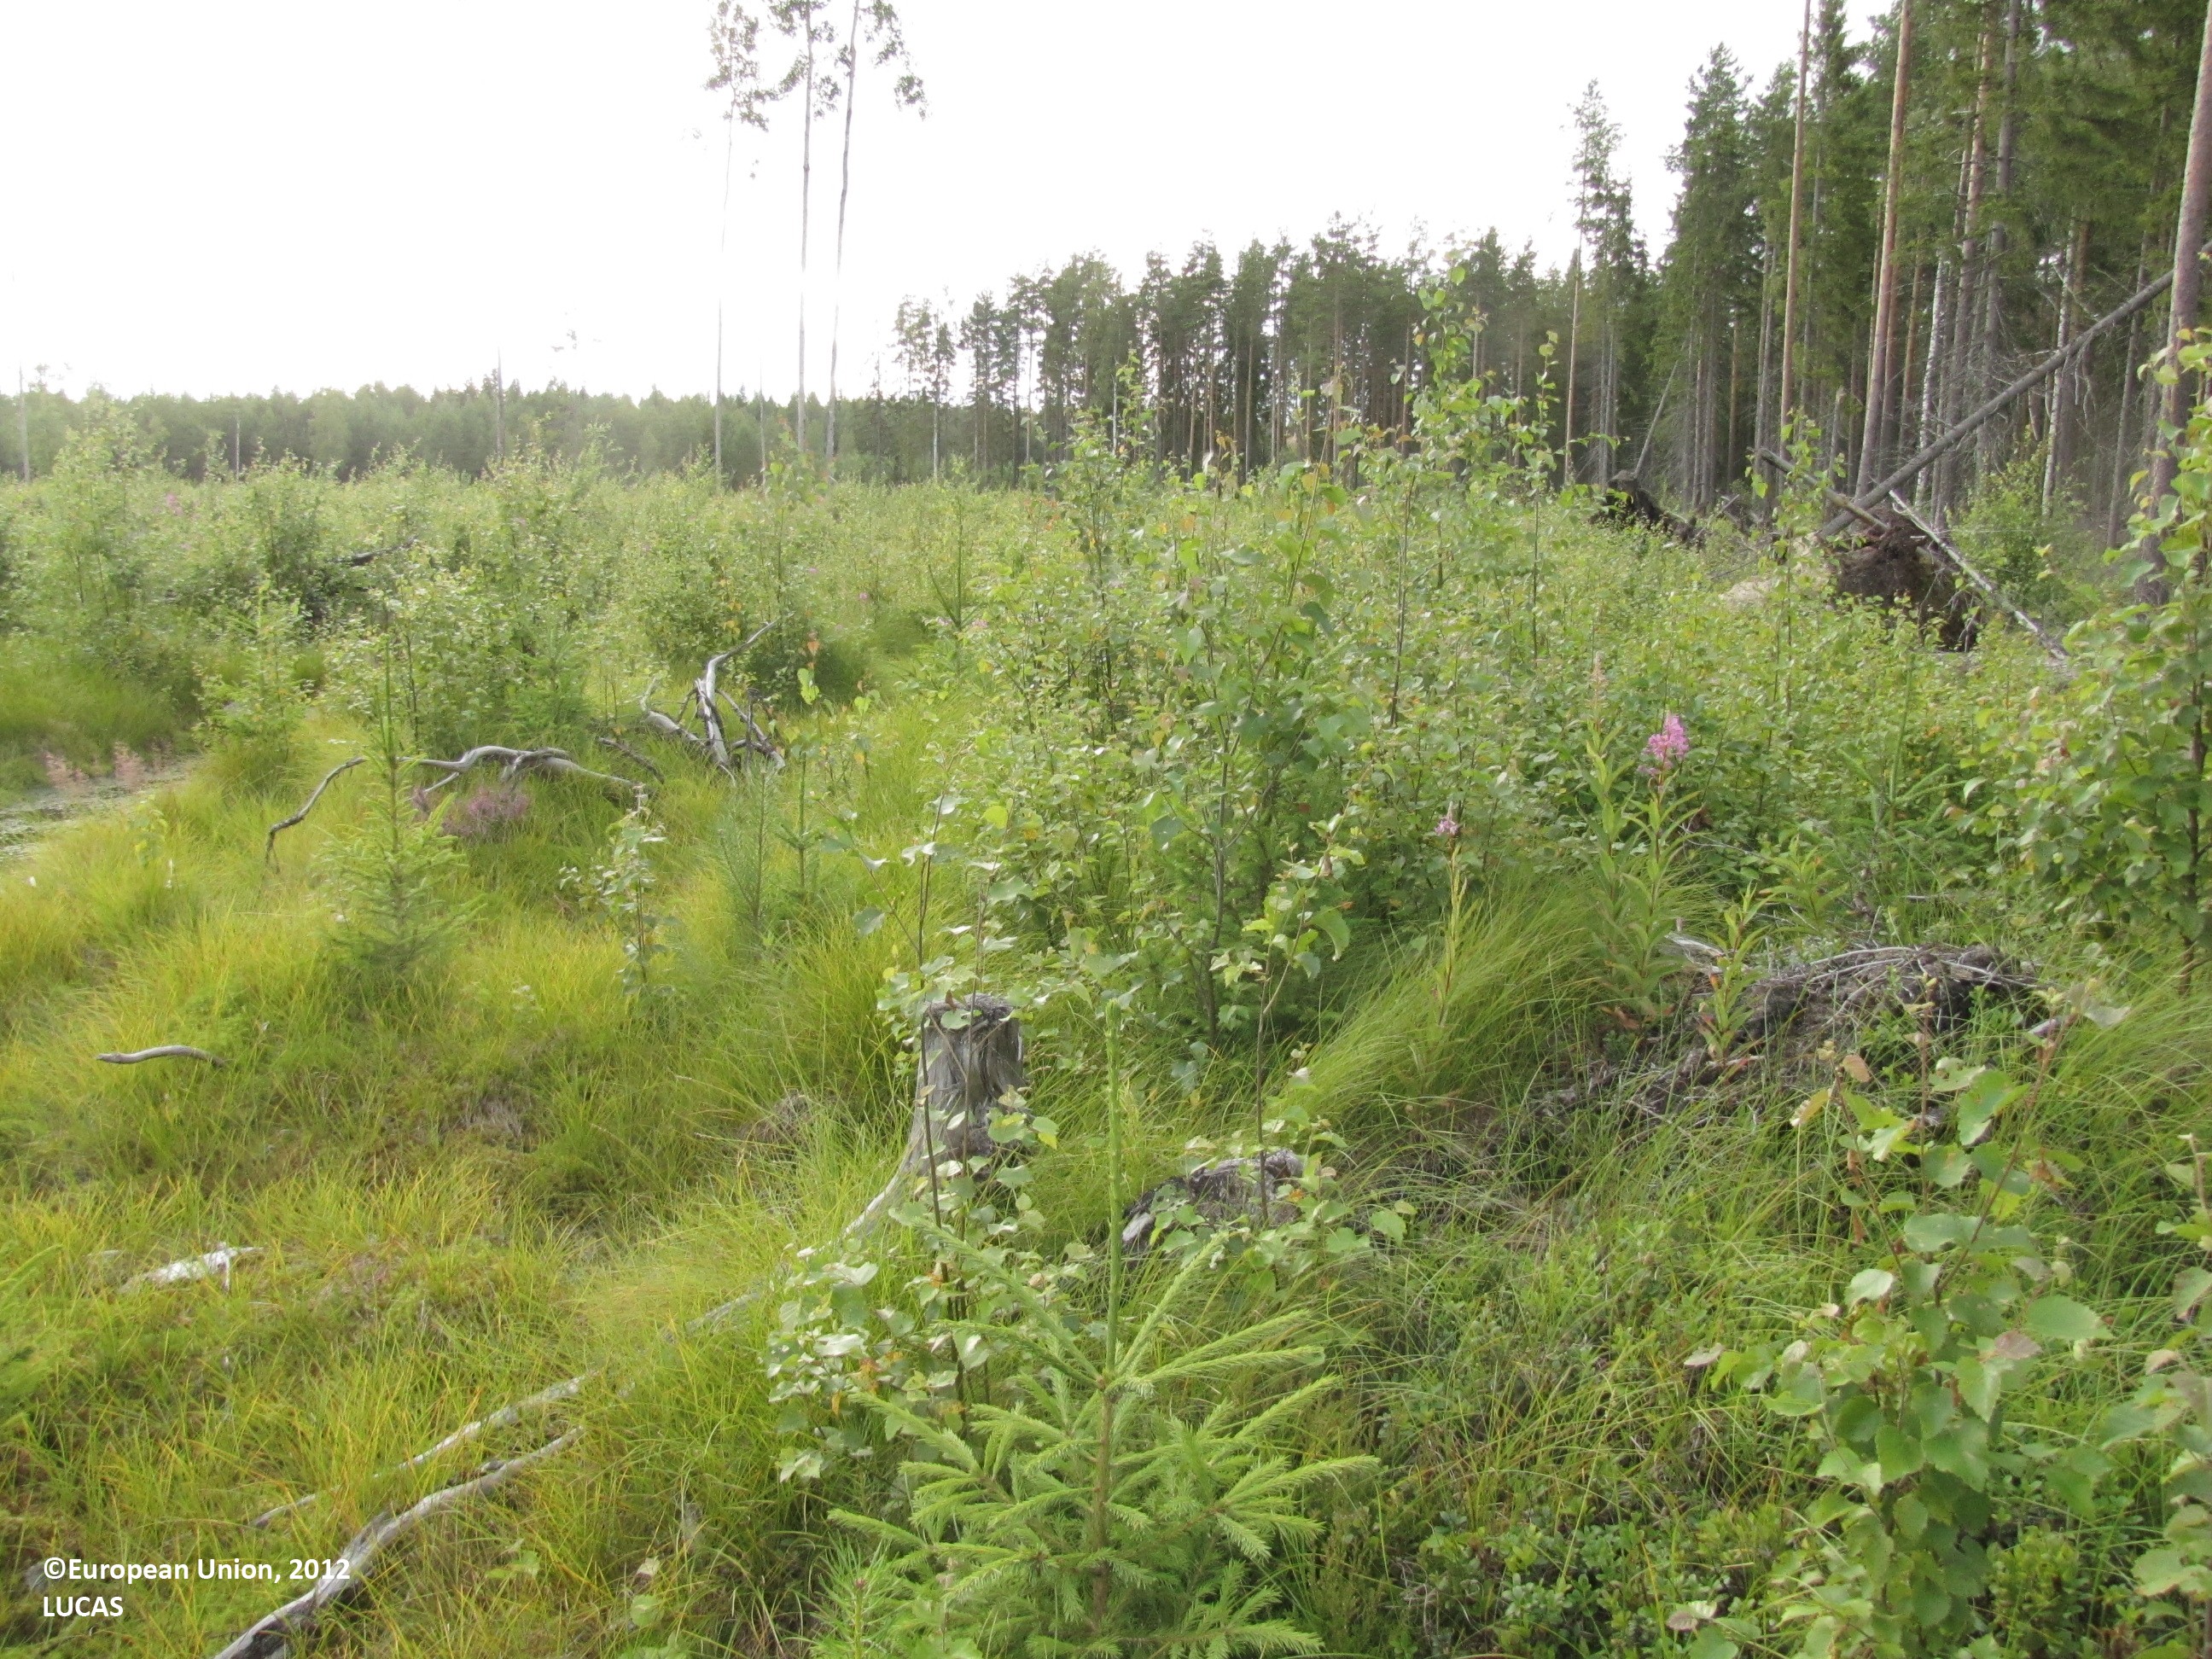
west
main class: Woodland
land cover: Spruce dominated mixed woodland
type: boreal forest
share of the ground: 50 - 75 %
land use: Forestry
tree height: < 5 m
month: July
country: FI
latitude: 62.2885
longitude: 23.1558
